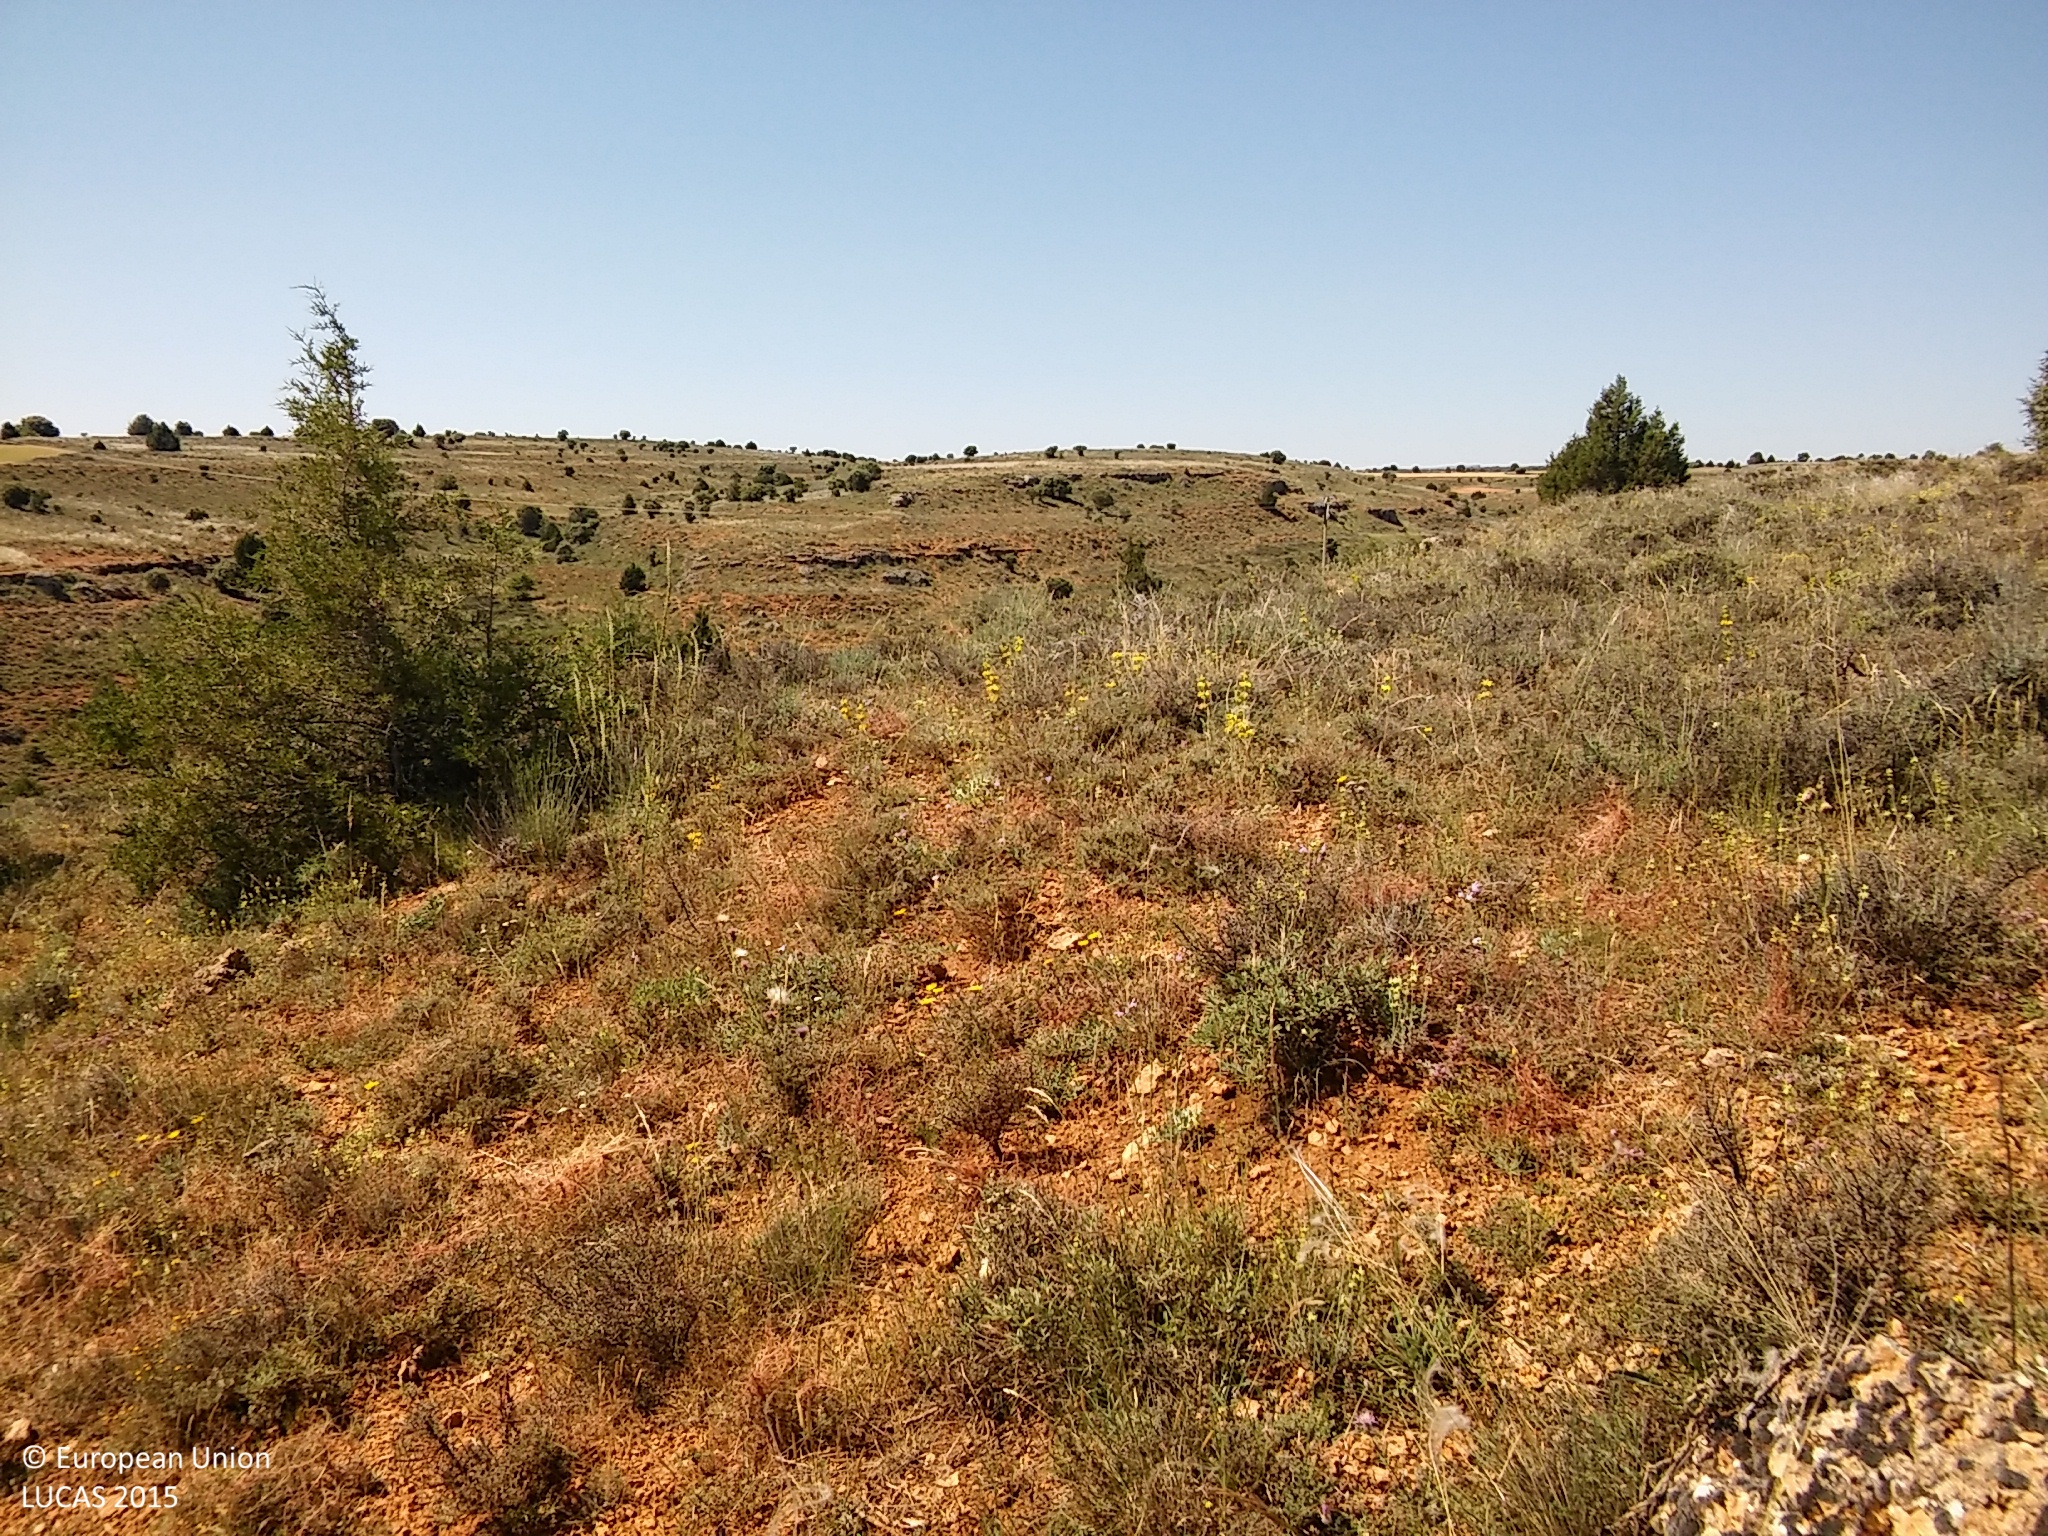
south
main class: Shrubland
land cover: Shrubland without tree cover
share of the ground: 50 - 75 %
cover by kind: shrubs 50 %, unconsolidated bare surface 50 %
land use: Agriculture (excluding fallow land and kitchen gardens)
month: June
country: ES
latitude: 41.4422
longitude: -3.1729
